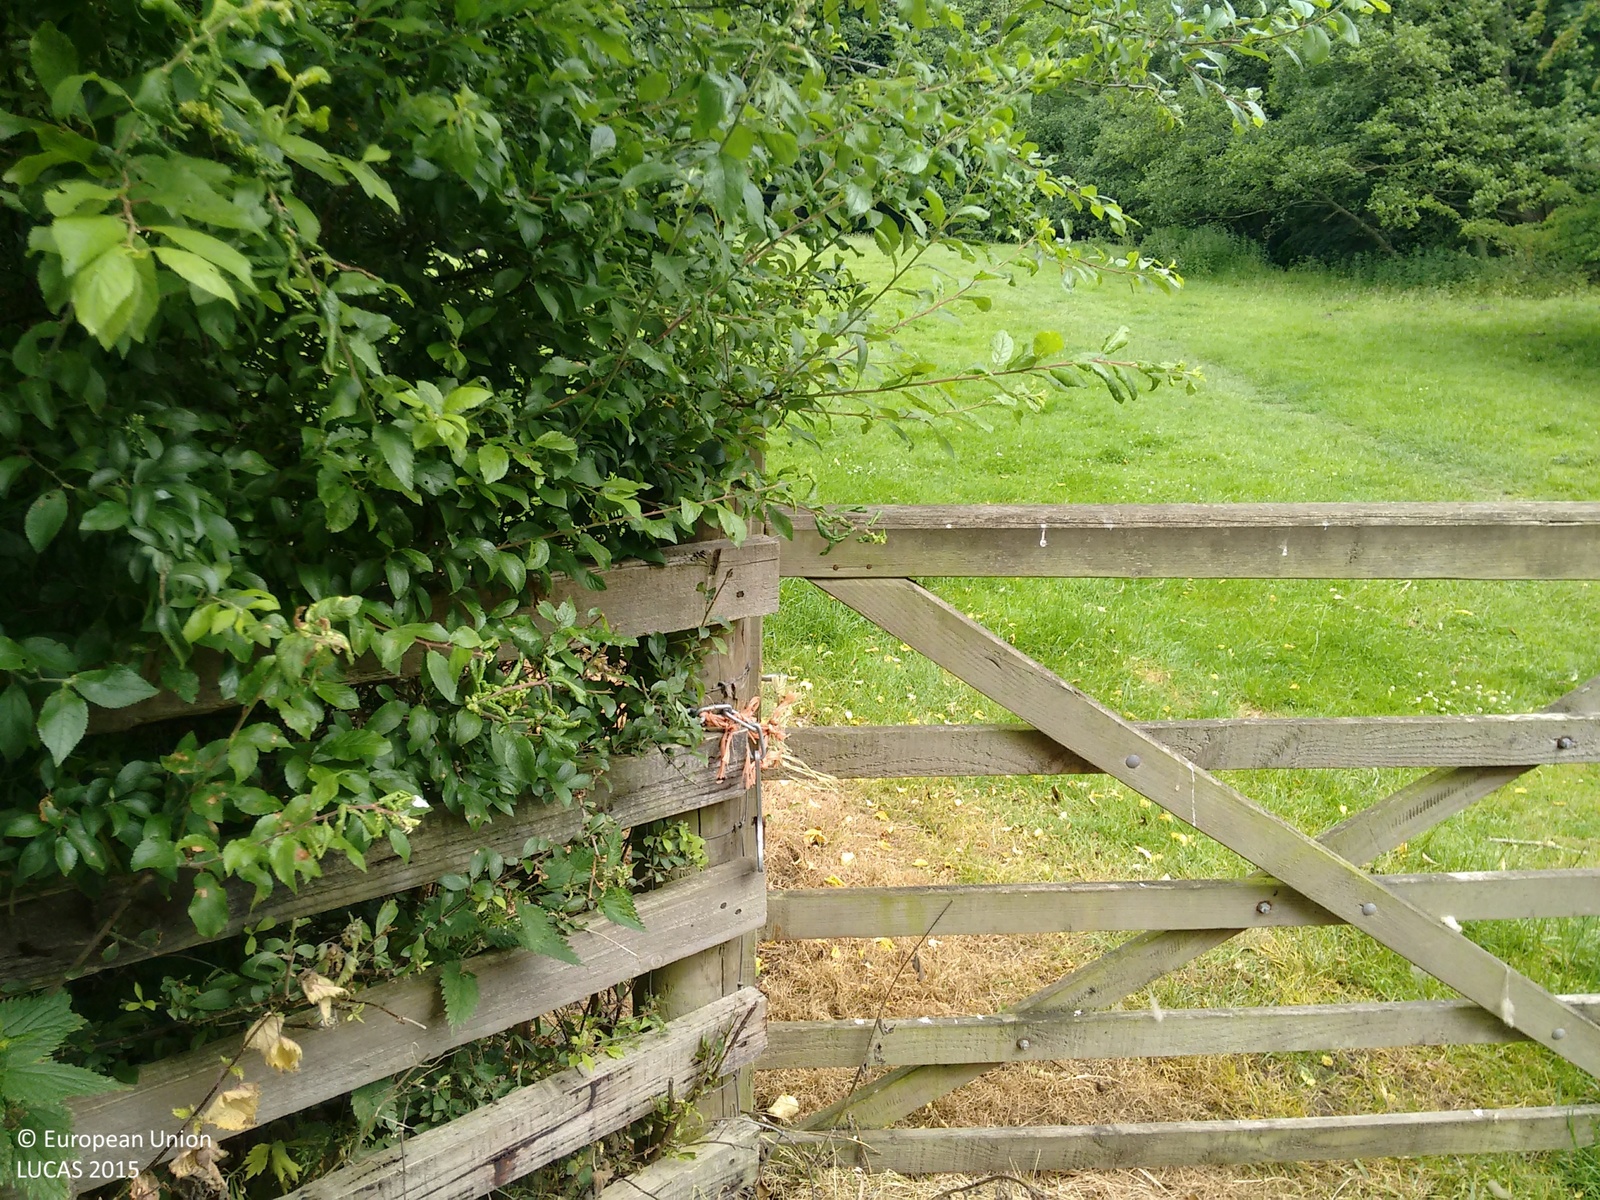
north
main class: Grassland
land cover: Grassland without tree/shrub cover
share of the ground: > 75 %
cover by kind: herbaceous plants 100 %
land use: Agriculture (excluding fallow land and kitchen gardens)
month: June
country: GB
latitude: 53.3272
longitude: -1.6587
